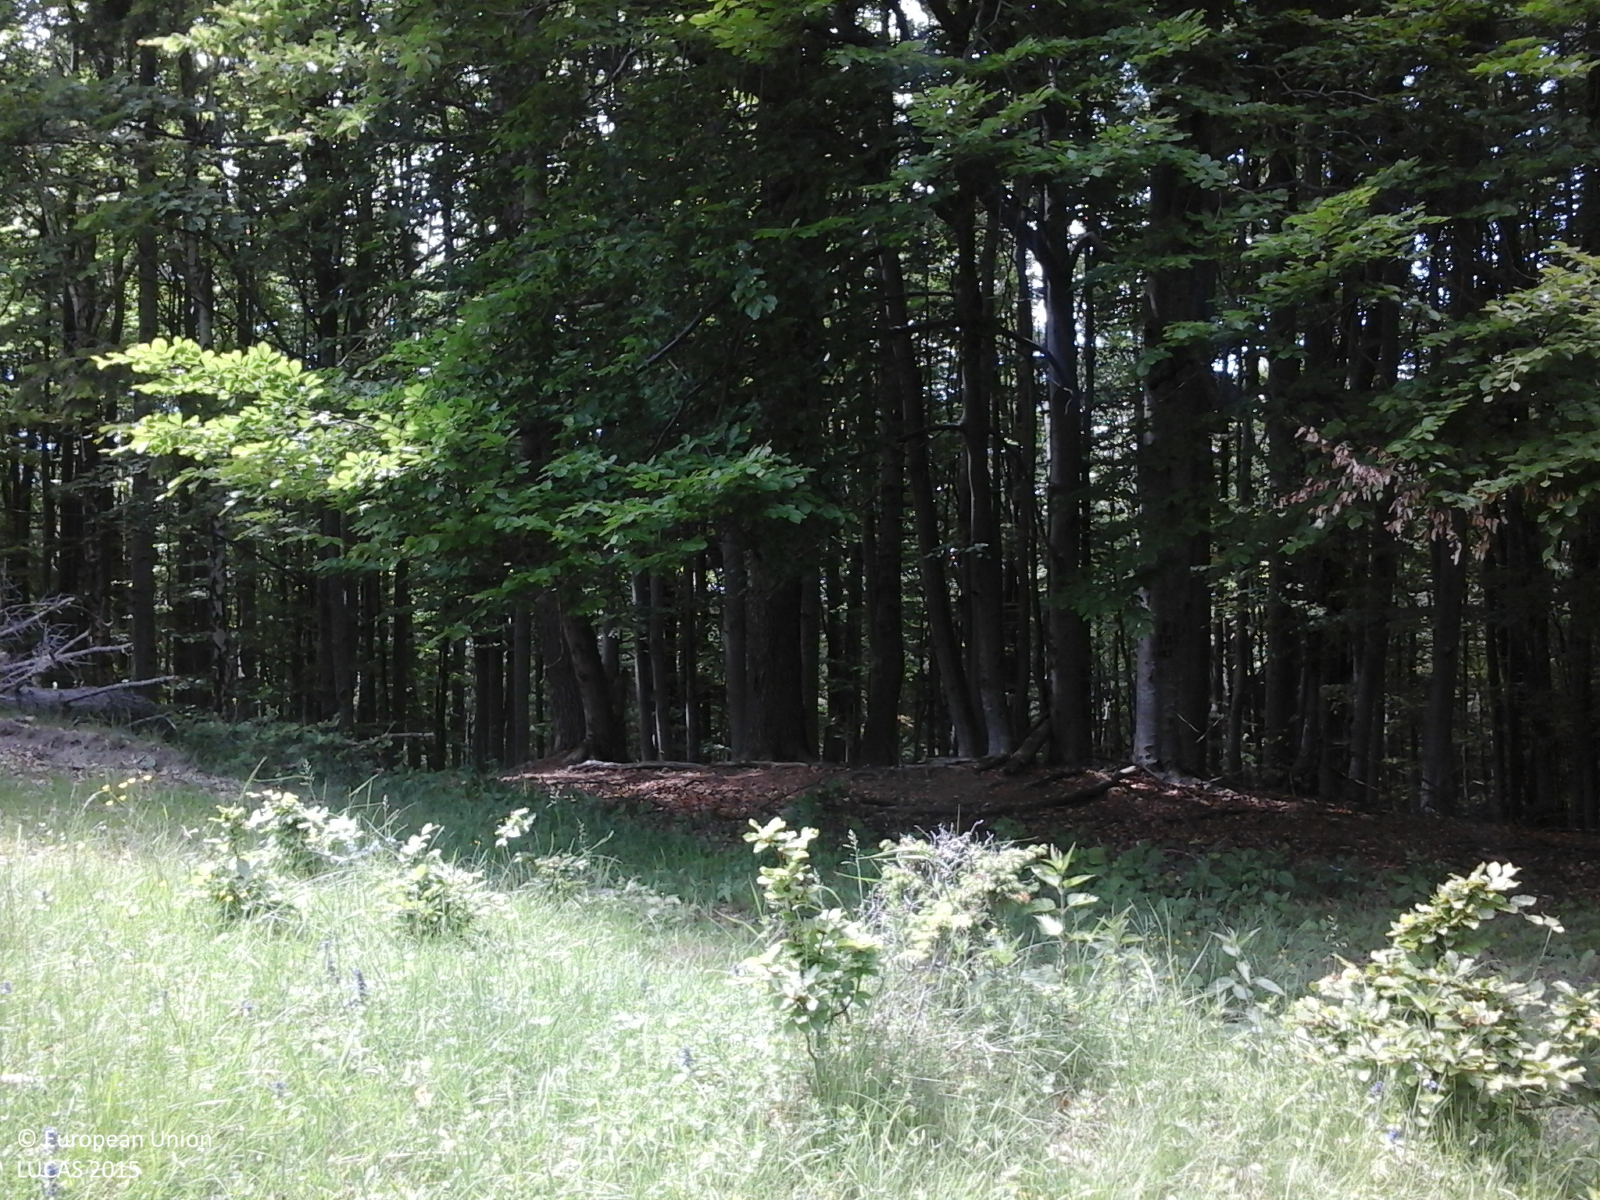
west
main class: Grassland
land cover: Grassland with sparse tree/shrub cover
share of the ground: > 75 %
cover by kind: herbaceous plants 90 %, broadleaved forest trees 5 %, shrubs 5 %
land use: Forestry
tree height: > 5 m
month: May
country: RO
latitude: 45.3974
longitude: 26.0951
